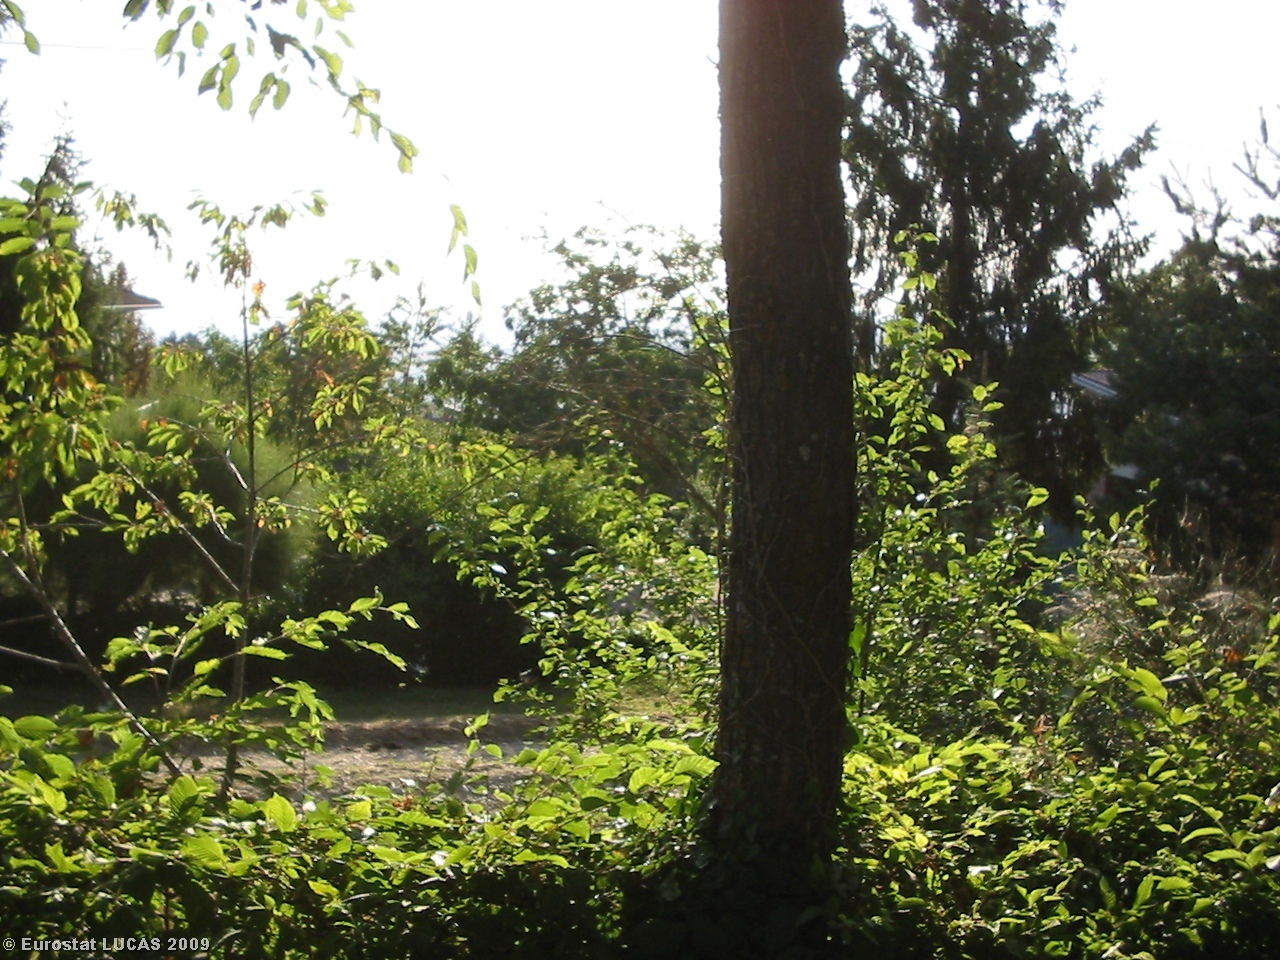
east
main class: Artificial land
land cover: Non built-up linear features
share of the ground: > 75 %
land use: Road transport
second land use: Agriculture (excluding fallow land and kitchen gardens)
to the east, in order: Artificial constructions in urban areas; Abandoned hedges; Lucerne; Grass margins; Ditches and canals; Paved roads, cycling and walking lanes; Mixed woodland; Grassland with sparse tree/shrub cover; Arable land (only in case pi)
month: July
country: IT
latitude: 44.5845
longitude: 10.3142
